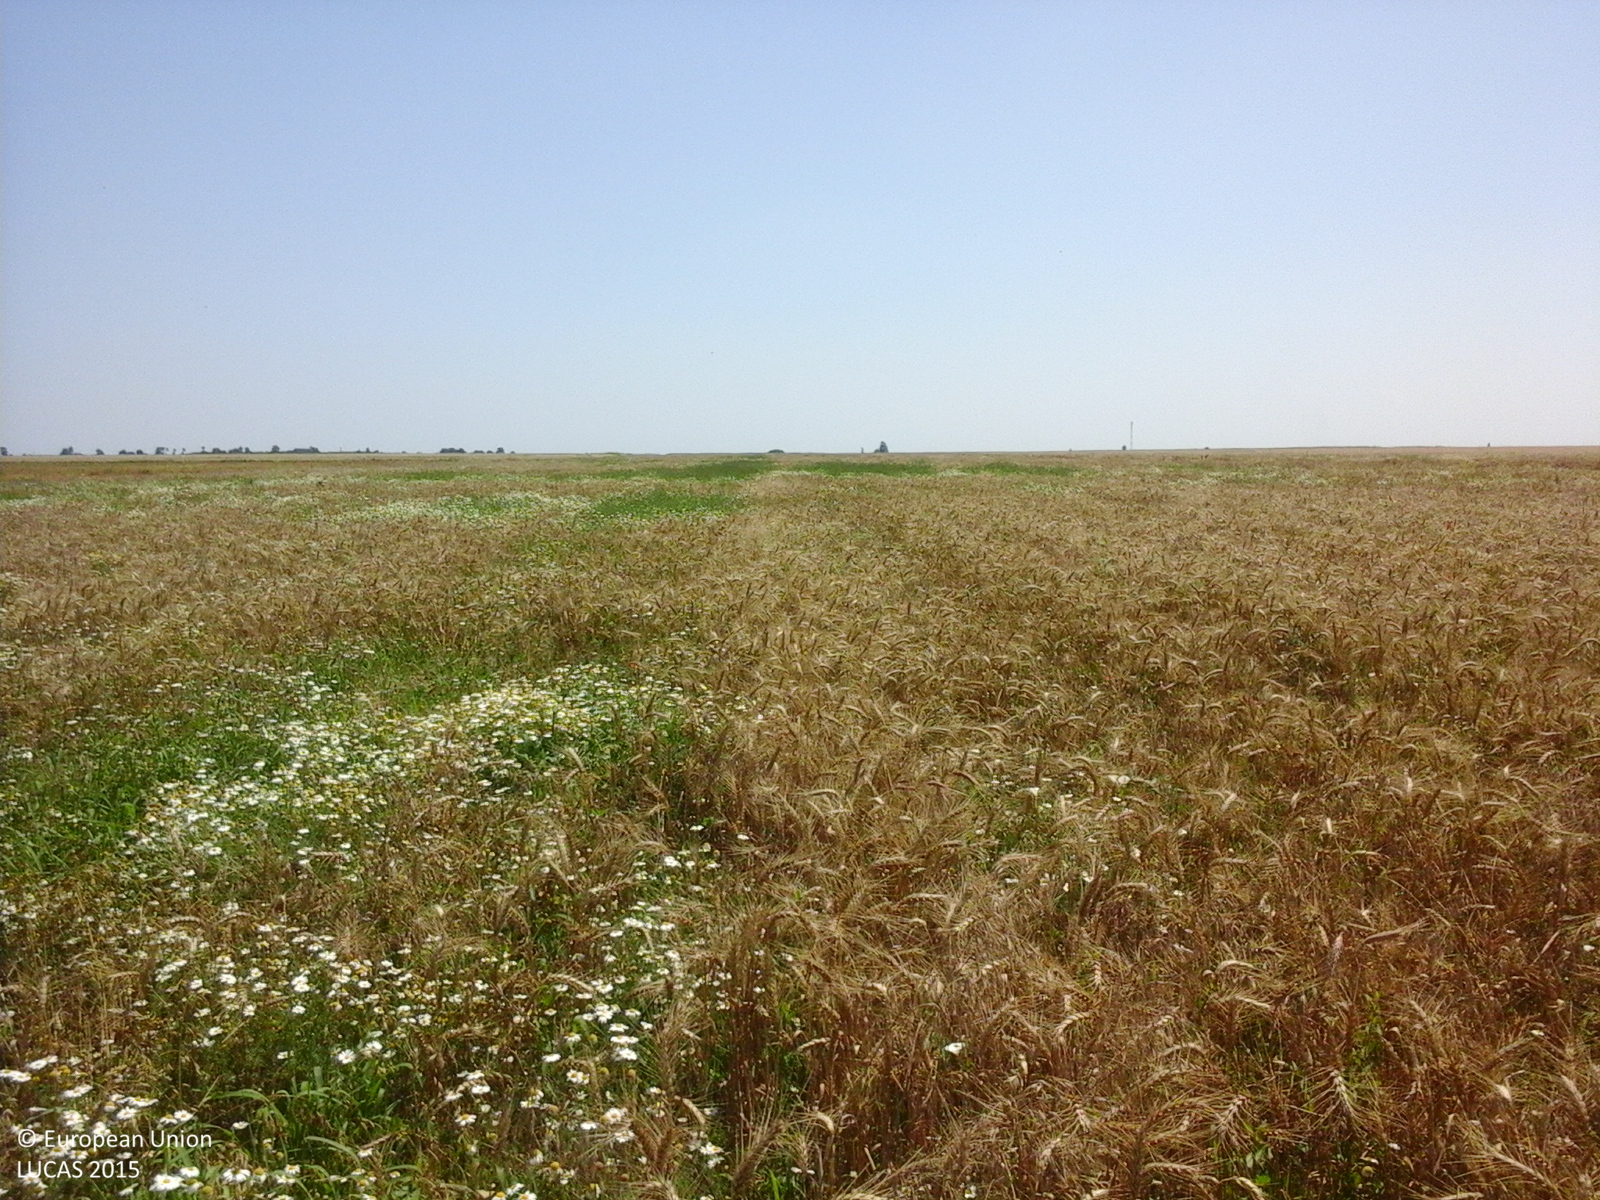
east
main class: Cropland
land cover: Common wheat
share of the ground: > 75 %
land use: Agriculture (excluding fallow land and kitchen gardens)
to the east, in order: Common wheat
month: July
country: RO
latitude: 44.4199
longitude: 24.5272
